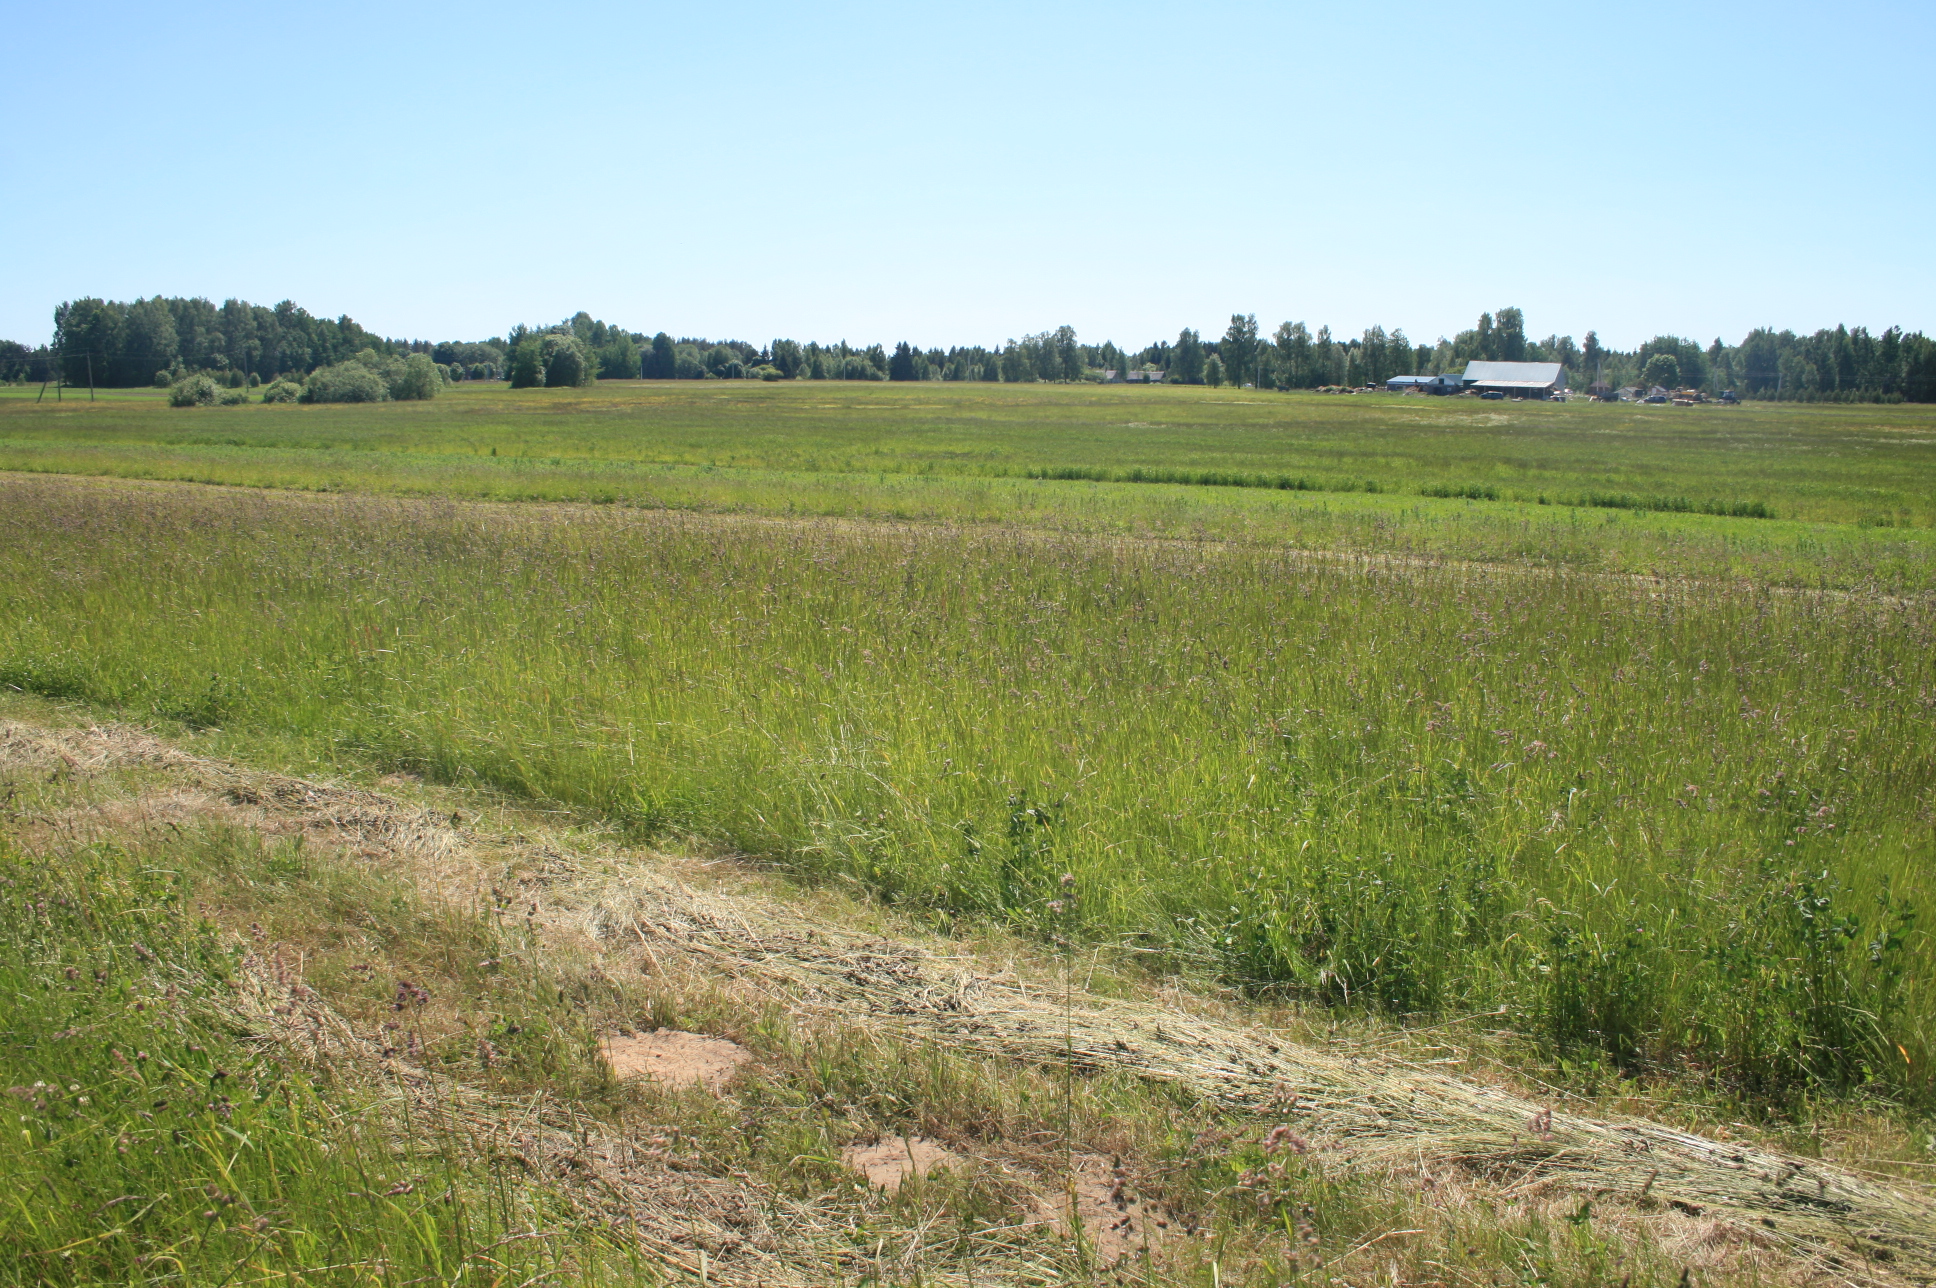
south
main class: Grassland
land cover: Grassland without tree/shrub cover
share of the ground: > 75 %
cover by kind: herbaceous plants 100 %
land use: Agriculture (excluding fallow land and kitchen gardens)
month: June
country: LT
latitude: 55.5148
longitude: 22.1707
